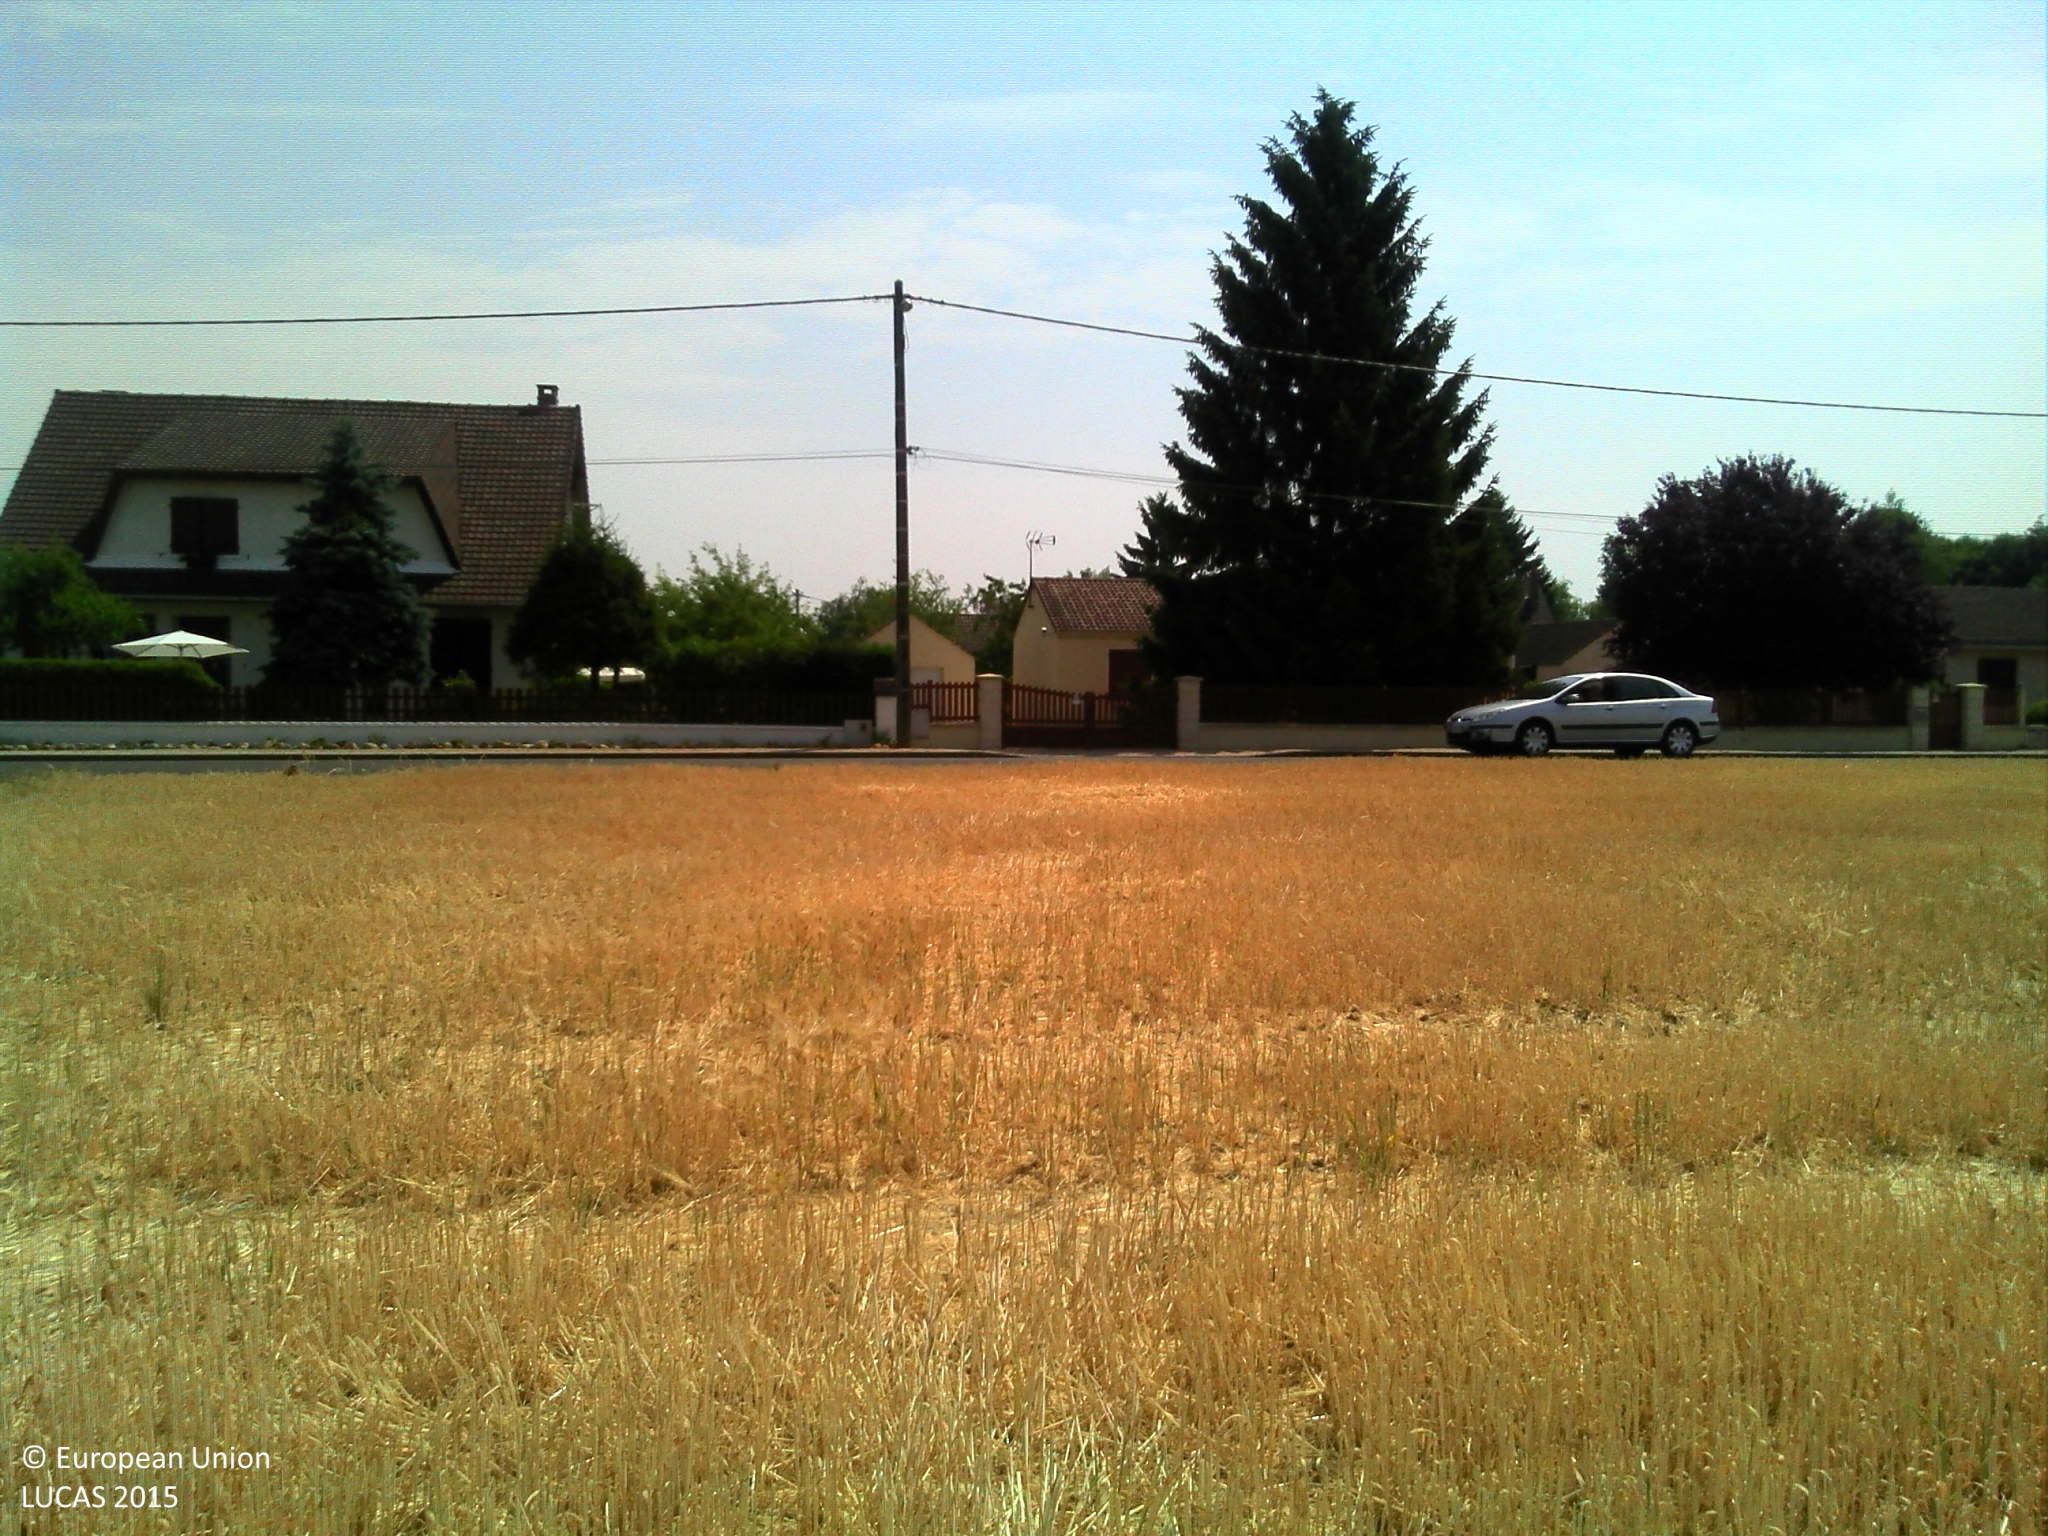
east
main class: Cropland
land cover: Barley
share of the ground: > 75 %
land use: Agriculture (excluding fallow land and kitchen gardens)
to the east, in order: Barley; Artificial constructions in urban areas
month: July
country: FR
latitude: 47.8105
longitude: 2.8484
